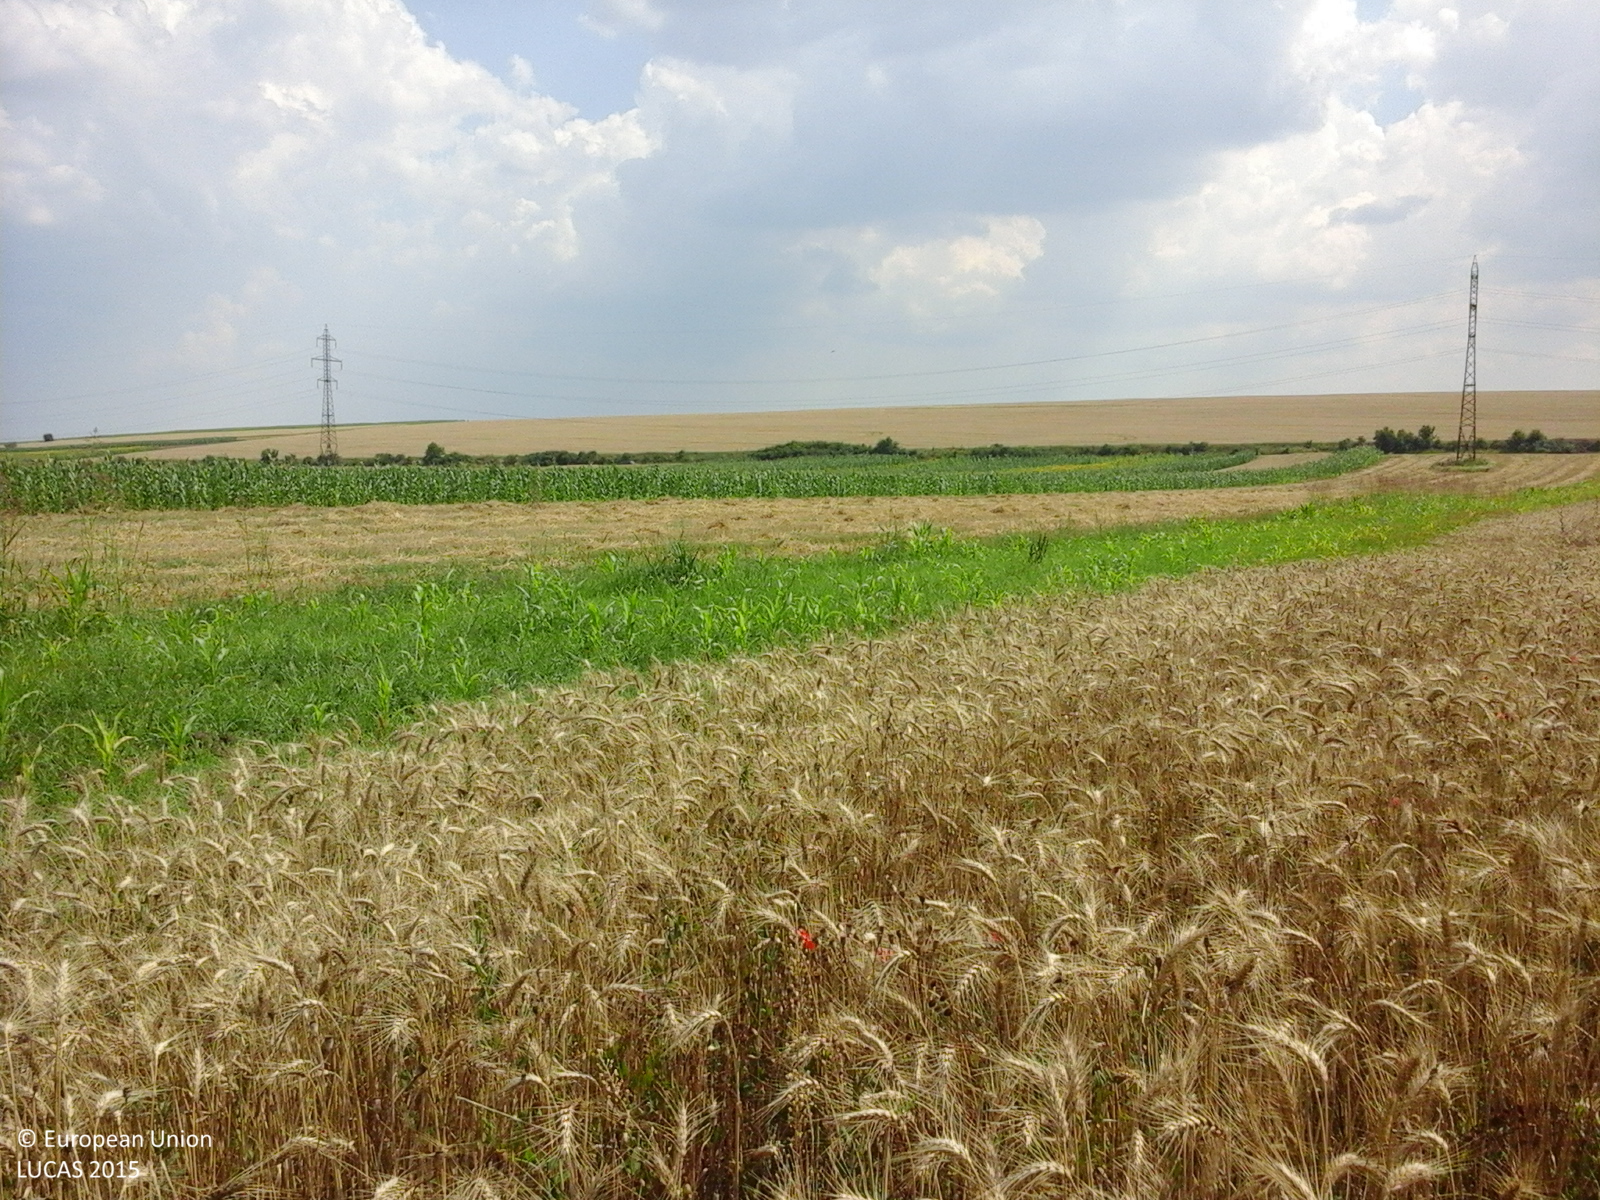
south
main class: Cropland
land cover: Common wheat
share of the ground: > 75 %
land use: Agriculture (excluding fallow land and kitchen gardens)
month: July
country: RO
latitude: 44.0132
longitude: 25.1858
